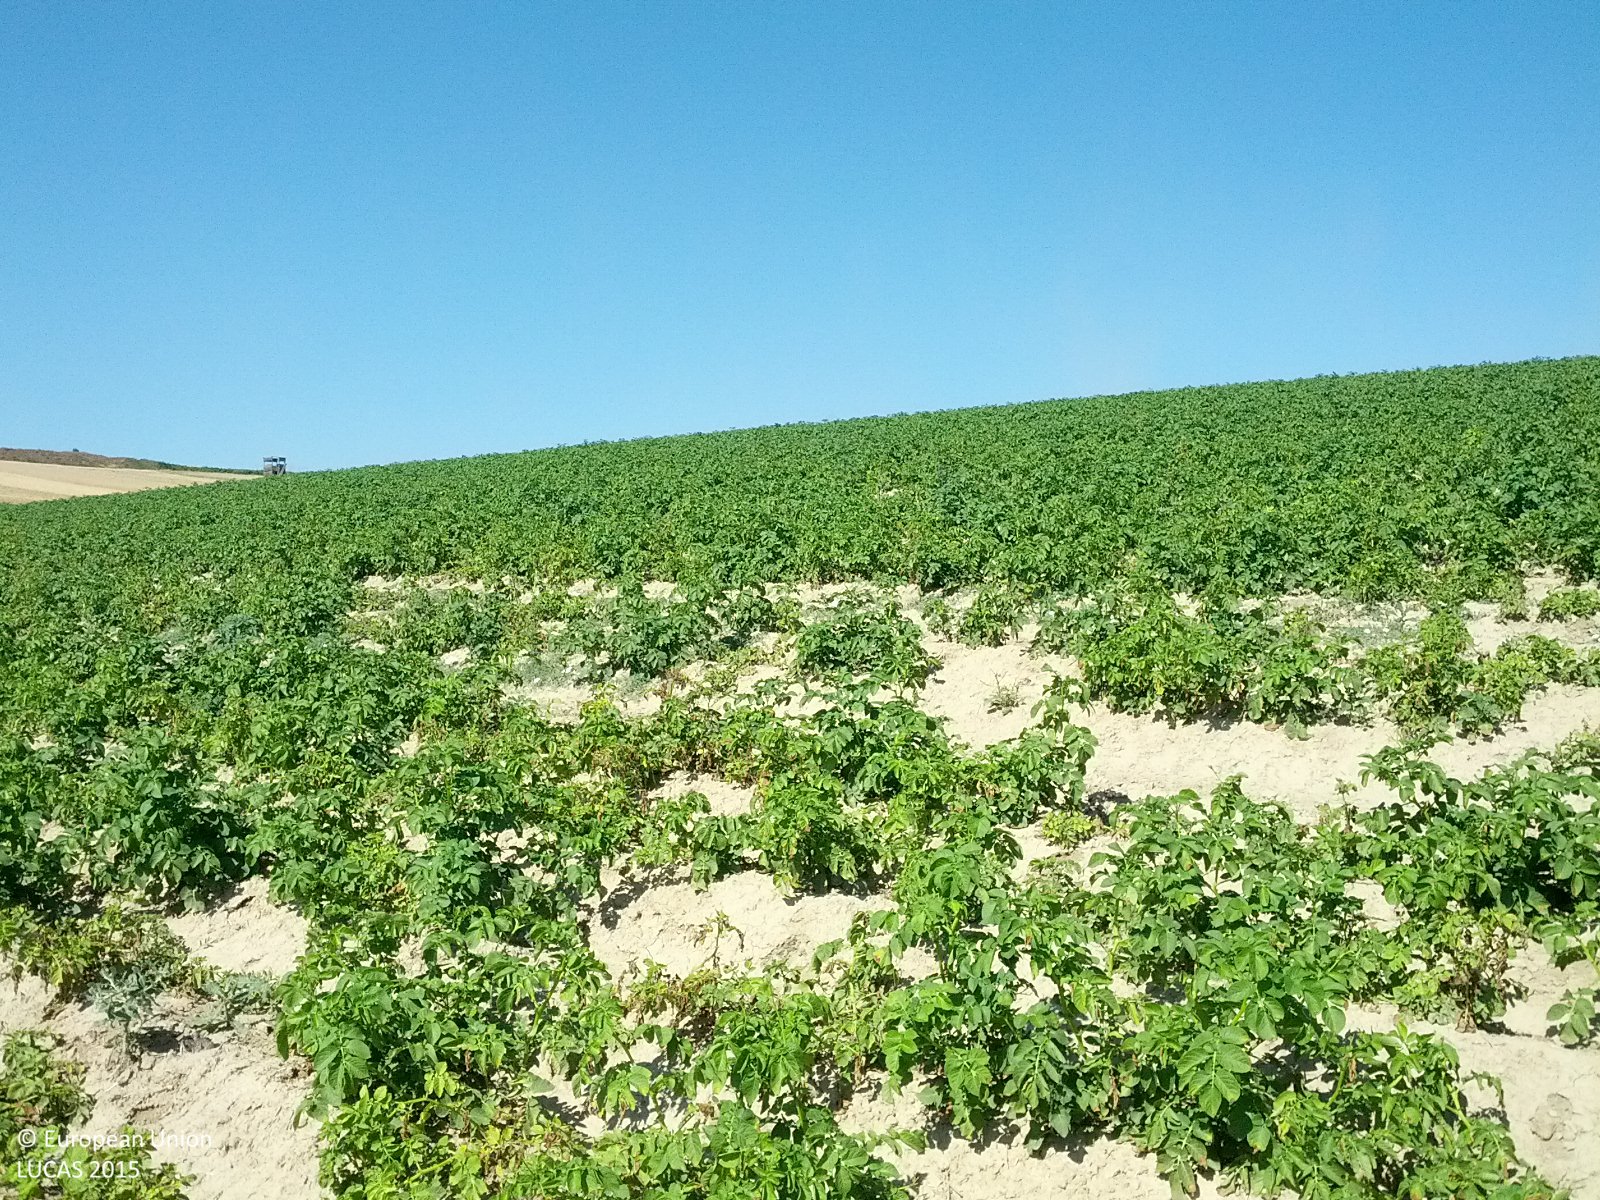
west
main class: Cropland
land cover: Potatoes
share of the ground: > 75 %
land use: Agriculture (excluding fallow land and kitchen gardens)
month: July
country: AT
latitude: 48.4679
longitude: 16.1315
